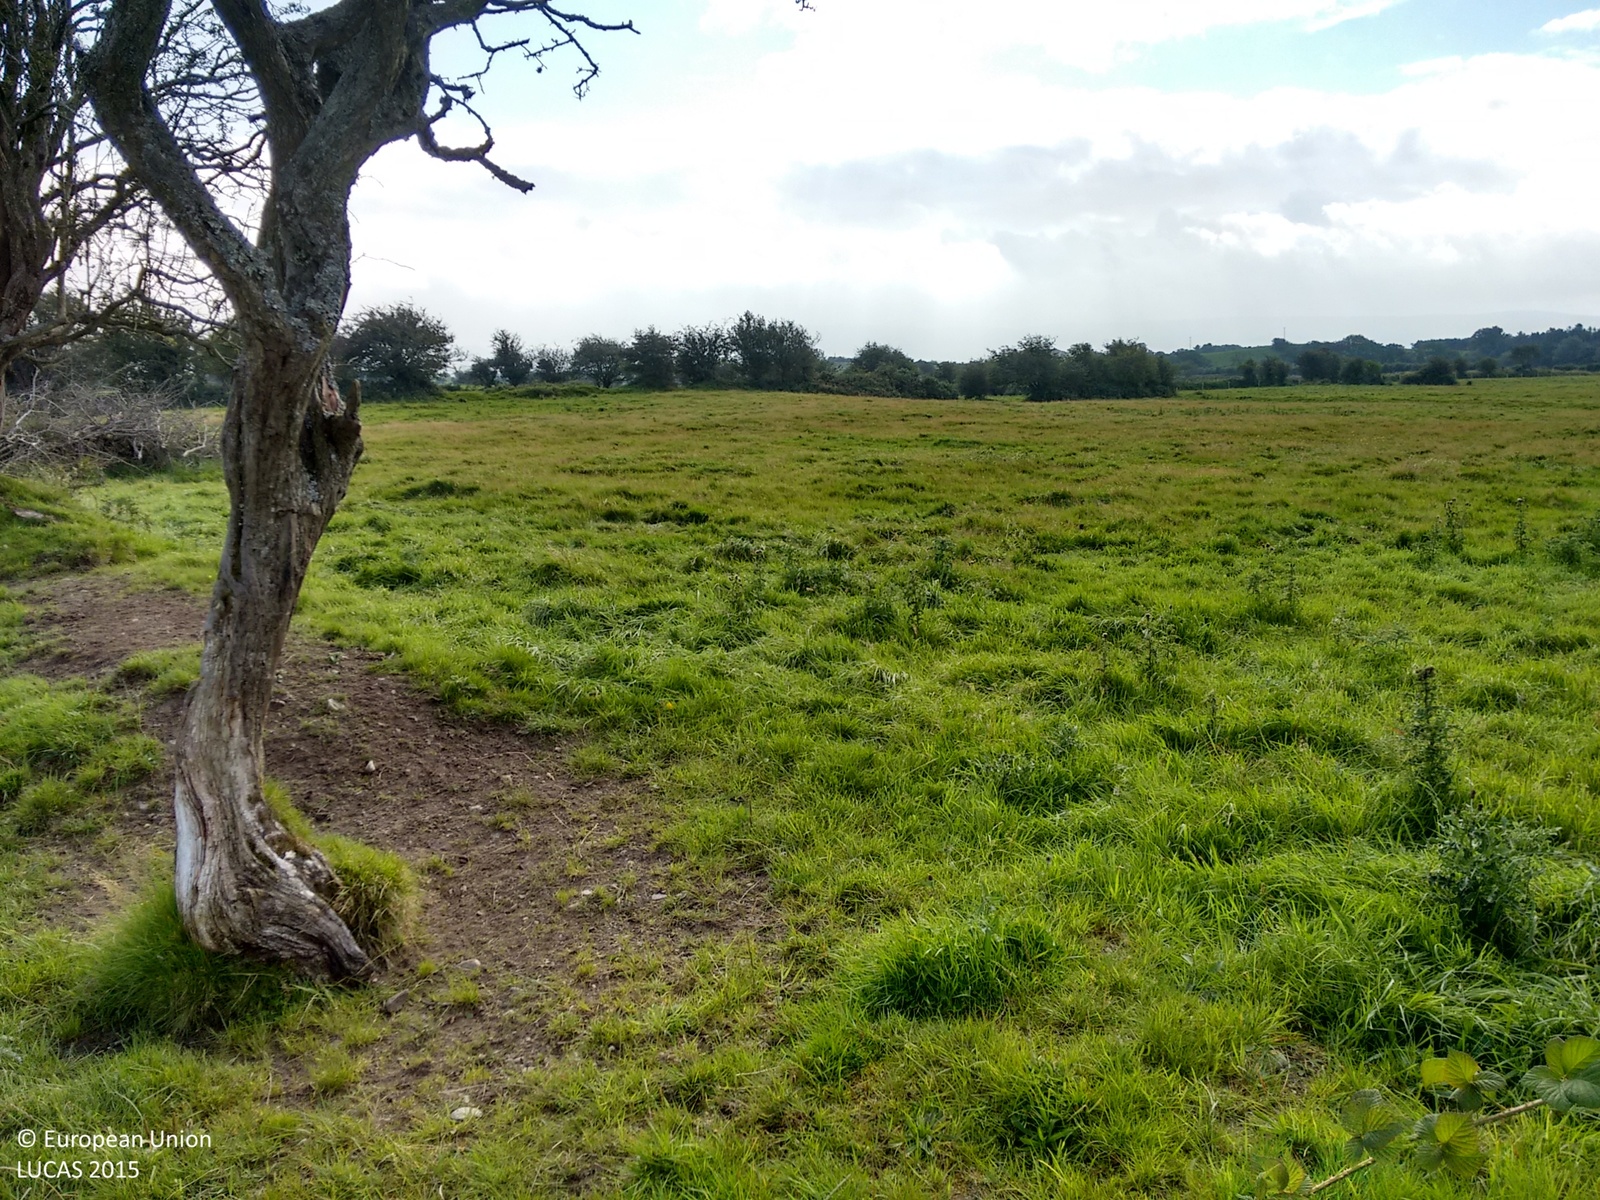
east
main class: Grassland
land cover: Grassland without tree/shrub cover
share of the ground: > 75 %
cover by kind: herbaceous plants 100 %
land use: Agriculture (excluding fallow land and kitchen gardens)
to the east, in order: Grassland without tree/shrub cover; Managed hedges; Grassland without tree/shrub cover; Fences; Managed hedges; Fences; Grassland without tree/shrub cover
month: September
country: IE
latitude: 54.1226
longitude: -9.0802
